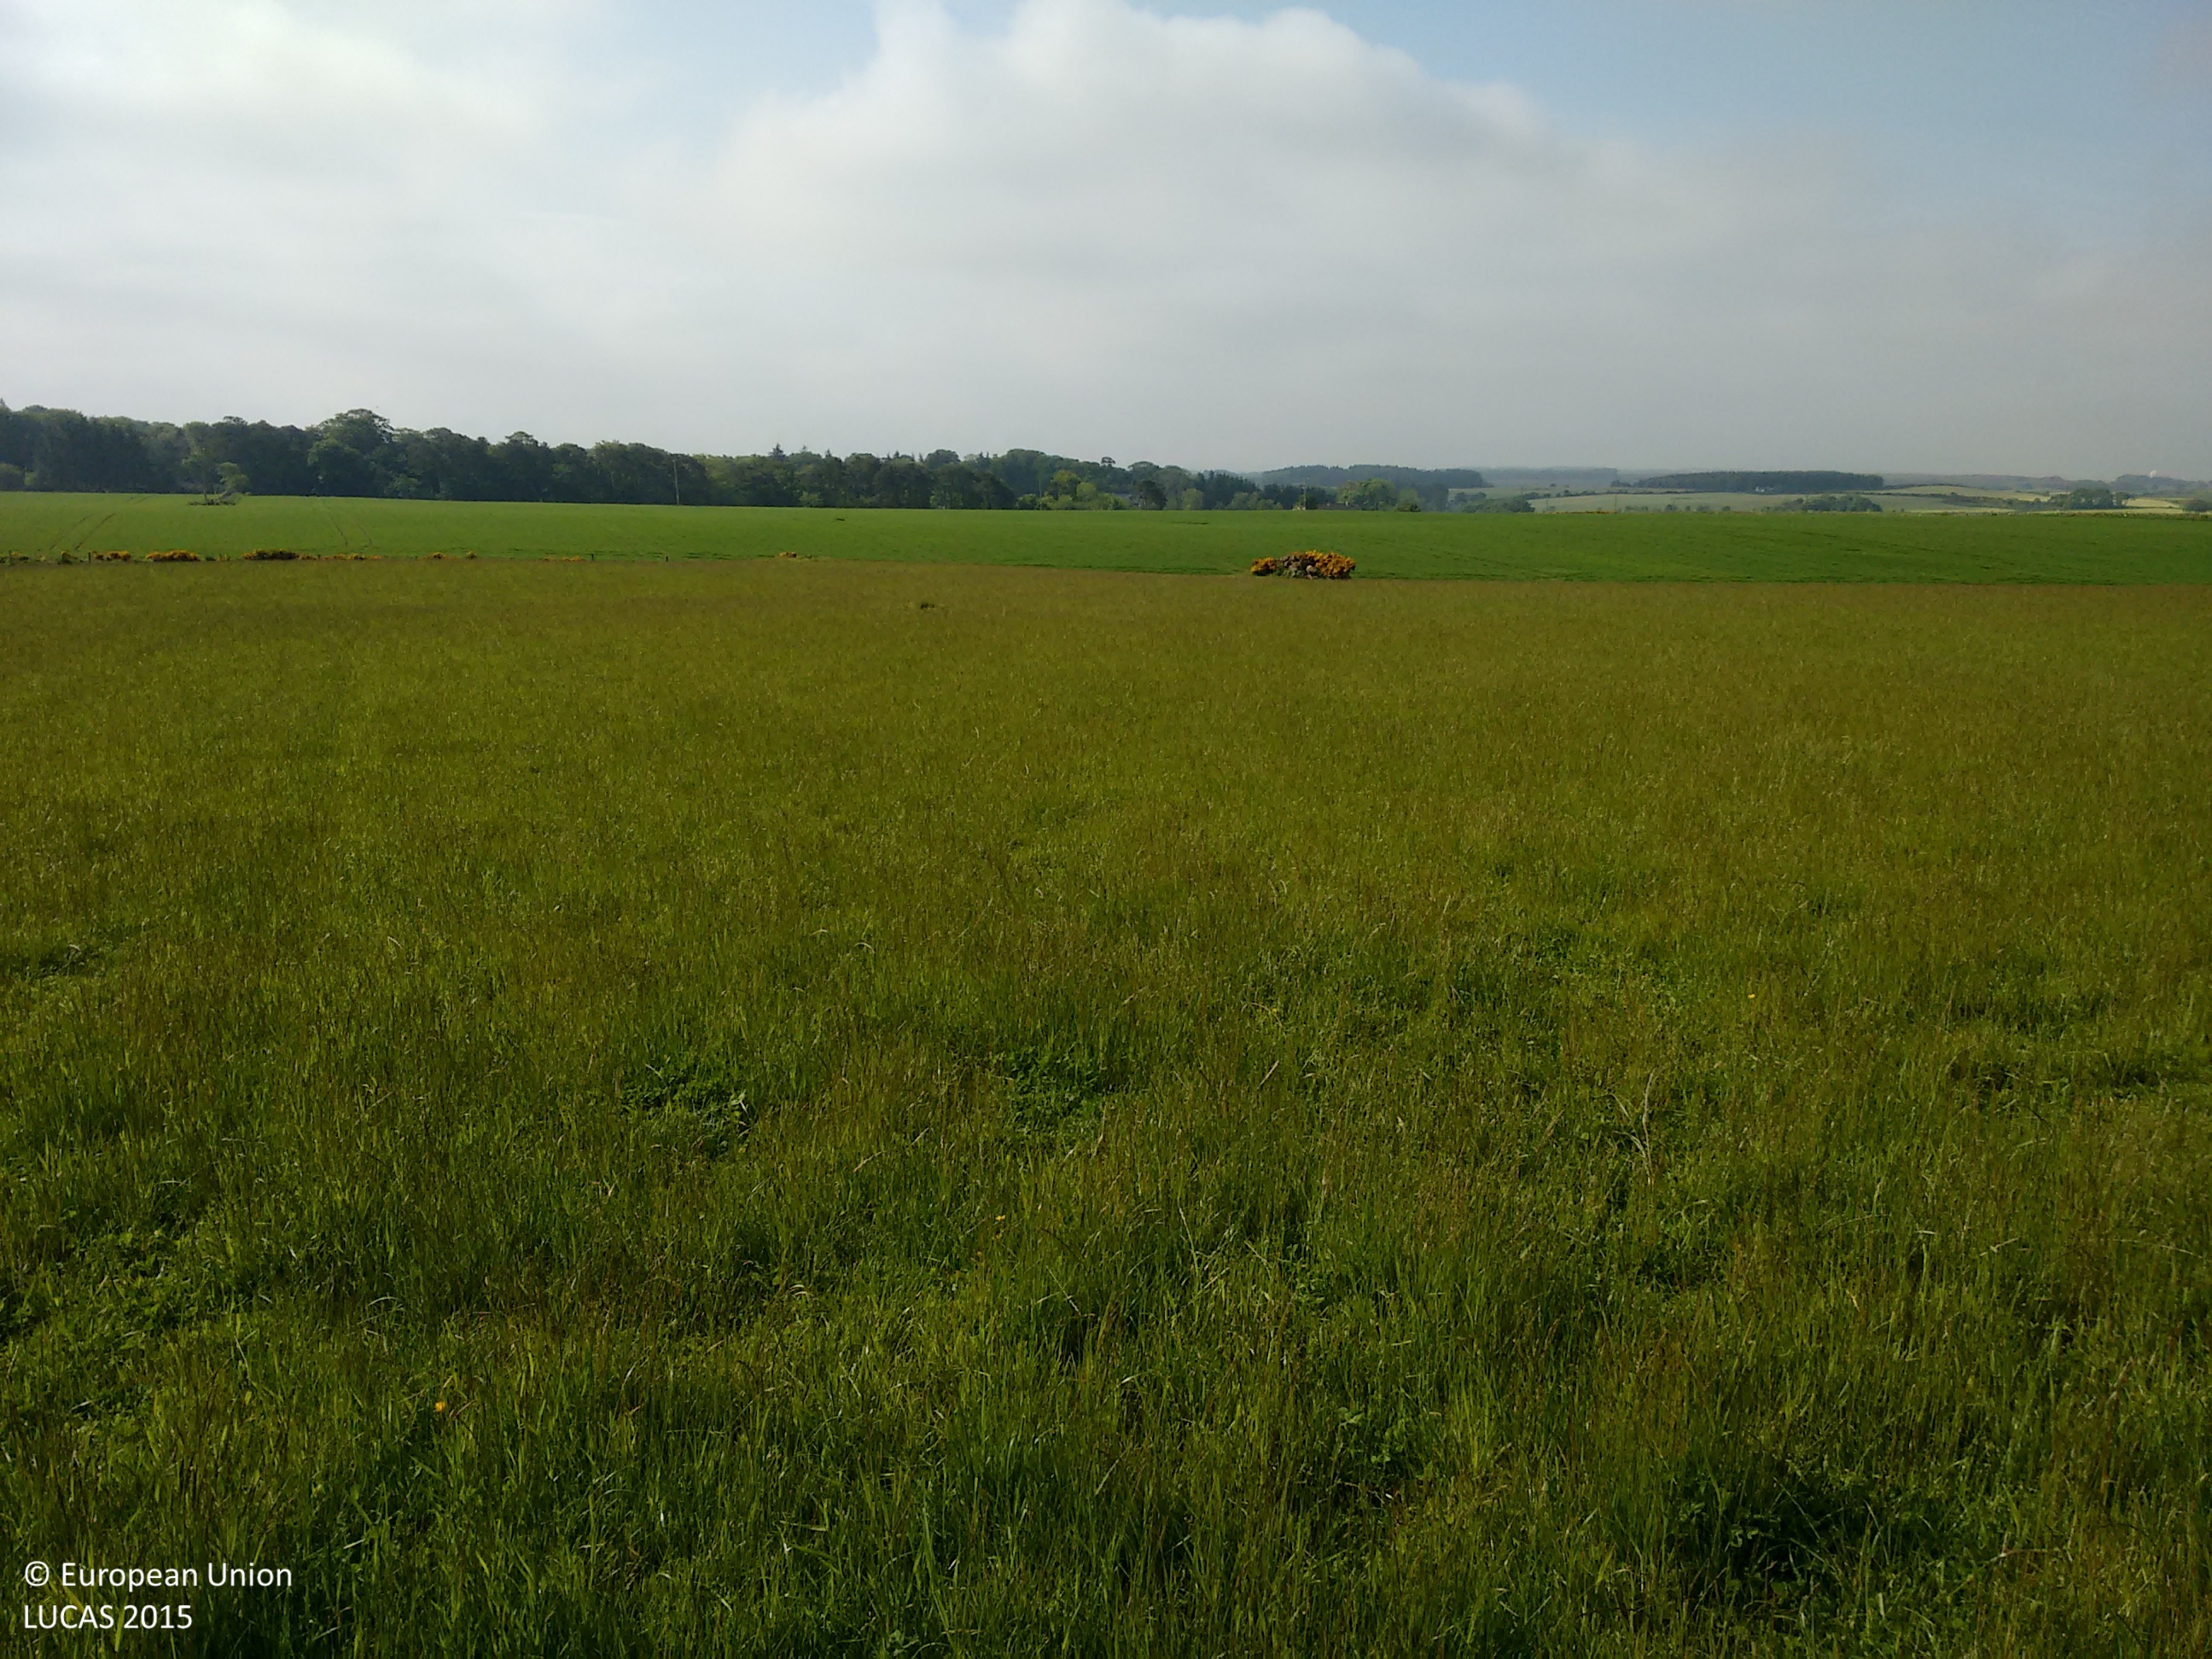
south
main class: Grassland
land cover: Grassland without tree/shrub cover
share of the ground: > 75 %
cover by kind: herbaceous plants 100 %
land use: Agriculture (excluding fallow land and kitchen gardens)
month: June
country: GB
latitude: 57.2516
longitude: -2.0975
